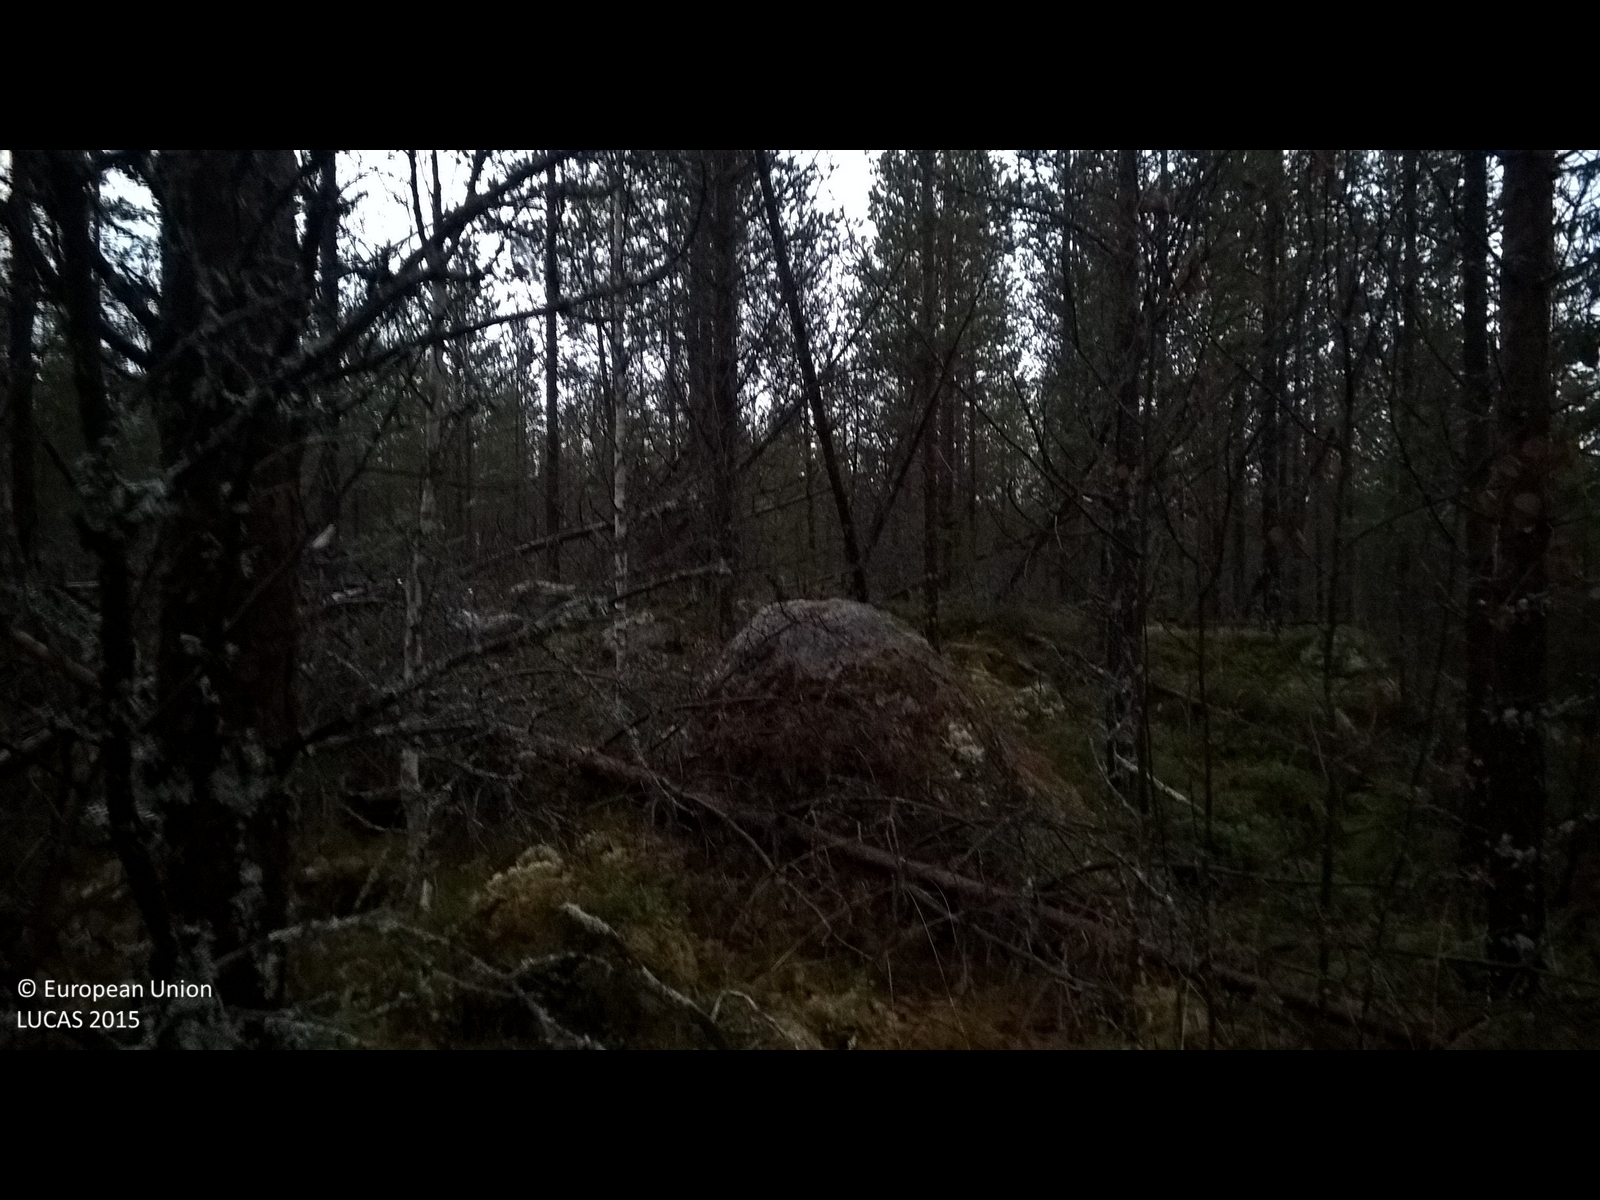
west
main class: Woodland
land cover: Pine dominated coniferous woodland
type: boreal forest
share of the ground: > 75 %
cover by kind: coniferous forest trees 70 %, broadleaved forest trees 10 %, shrubs 10 %, lichens and mosses 10 %
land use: Forestry
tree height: > 5 m
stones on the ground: < 10 %
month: November
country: SE
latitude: 61.9668
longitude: 15.0750
